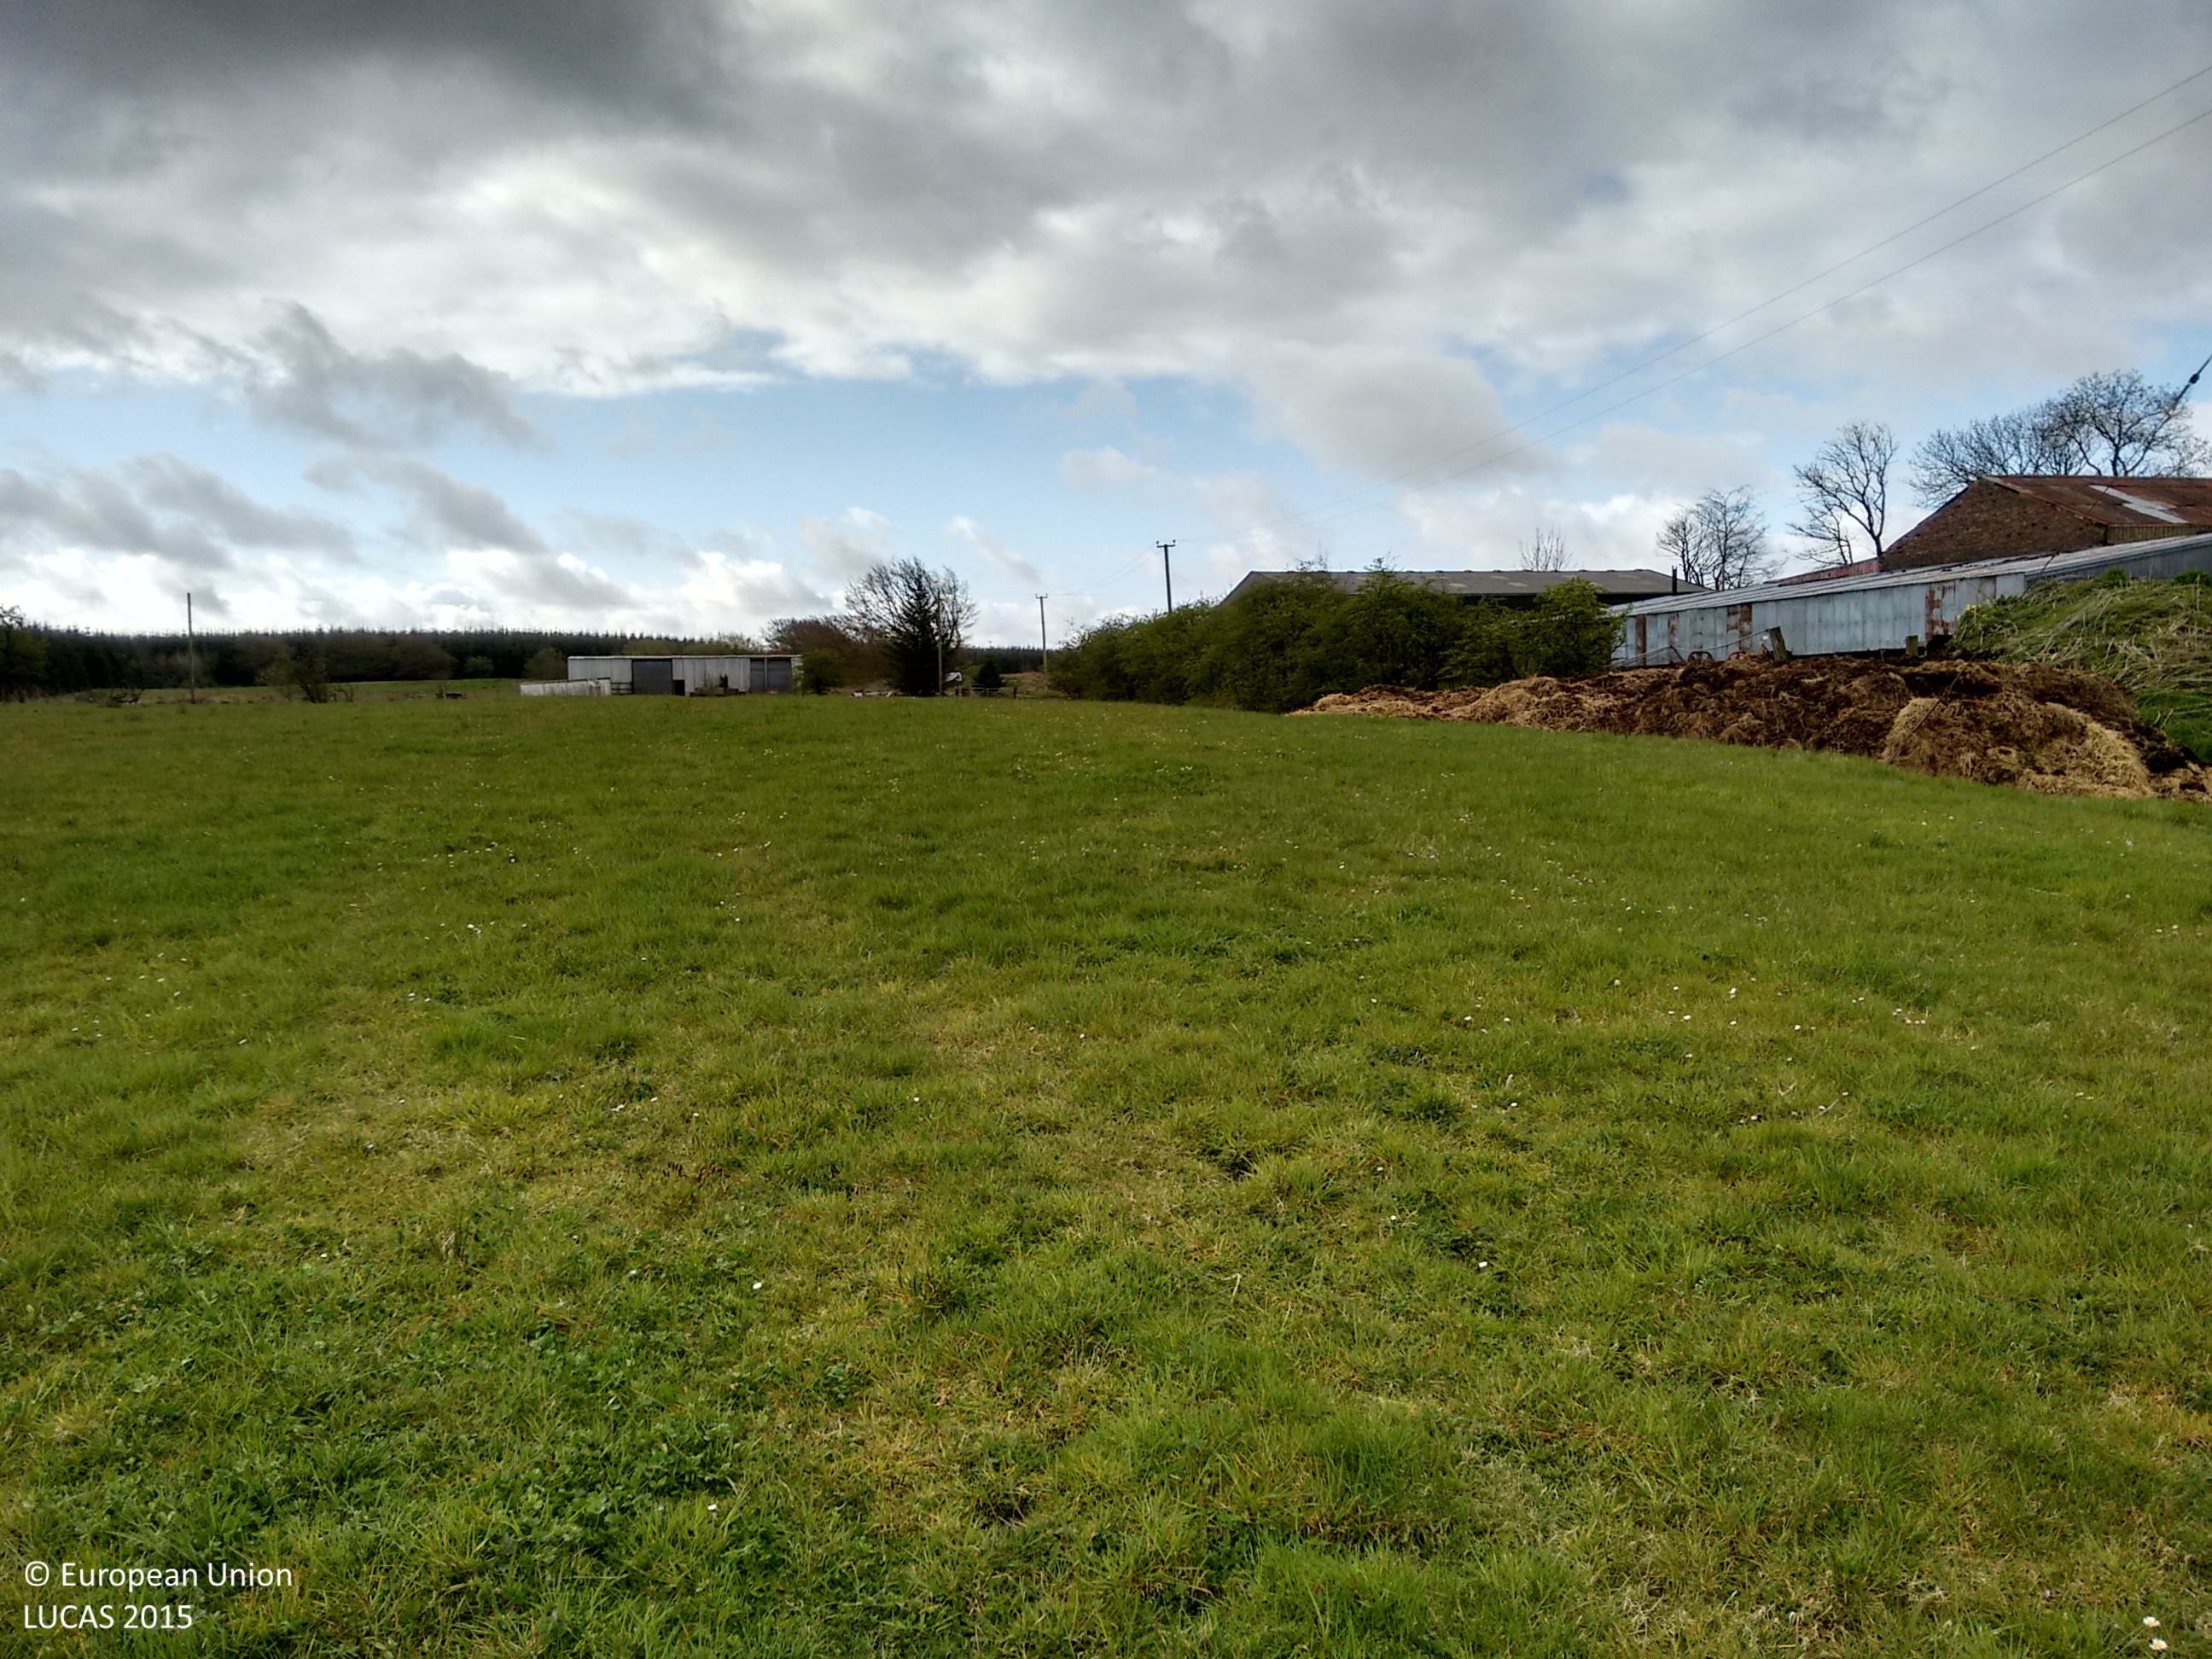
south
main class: Grassland
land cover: Grassland without tree/shrub cover
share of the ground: > 75 %
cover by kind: herbaceous plants 100 %
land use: Agriculture (excluding fallow land and kitchen gardens)
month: May
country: GB
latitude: 55.8250
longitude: -3.7630
